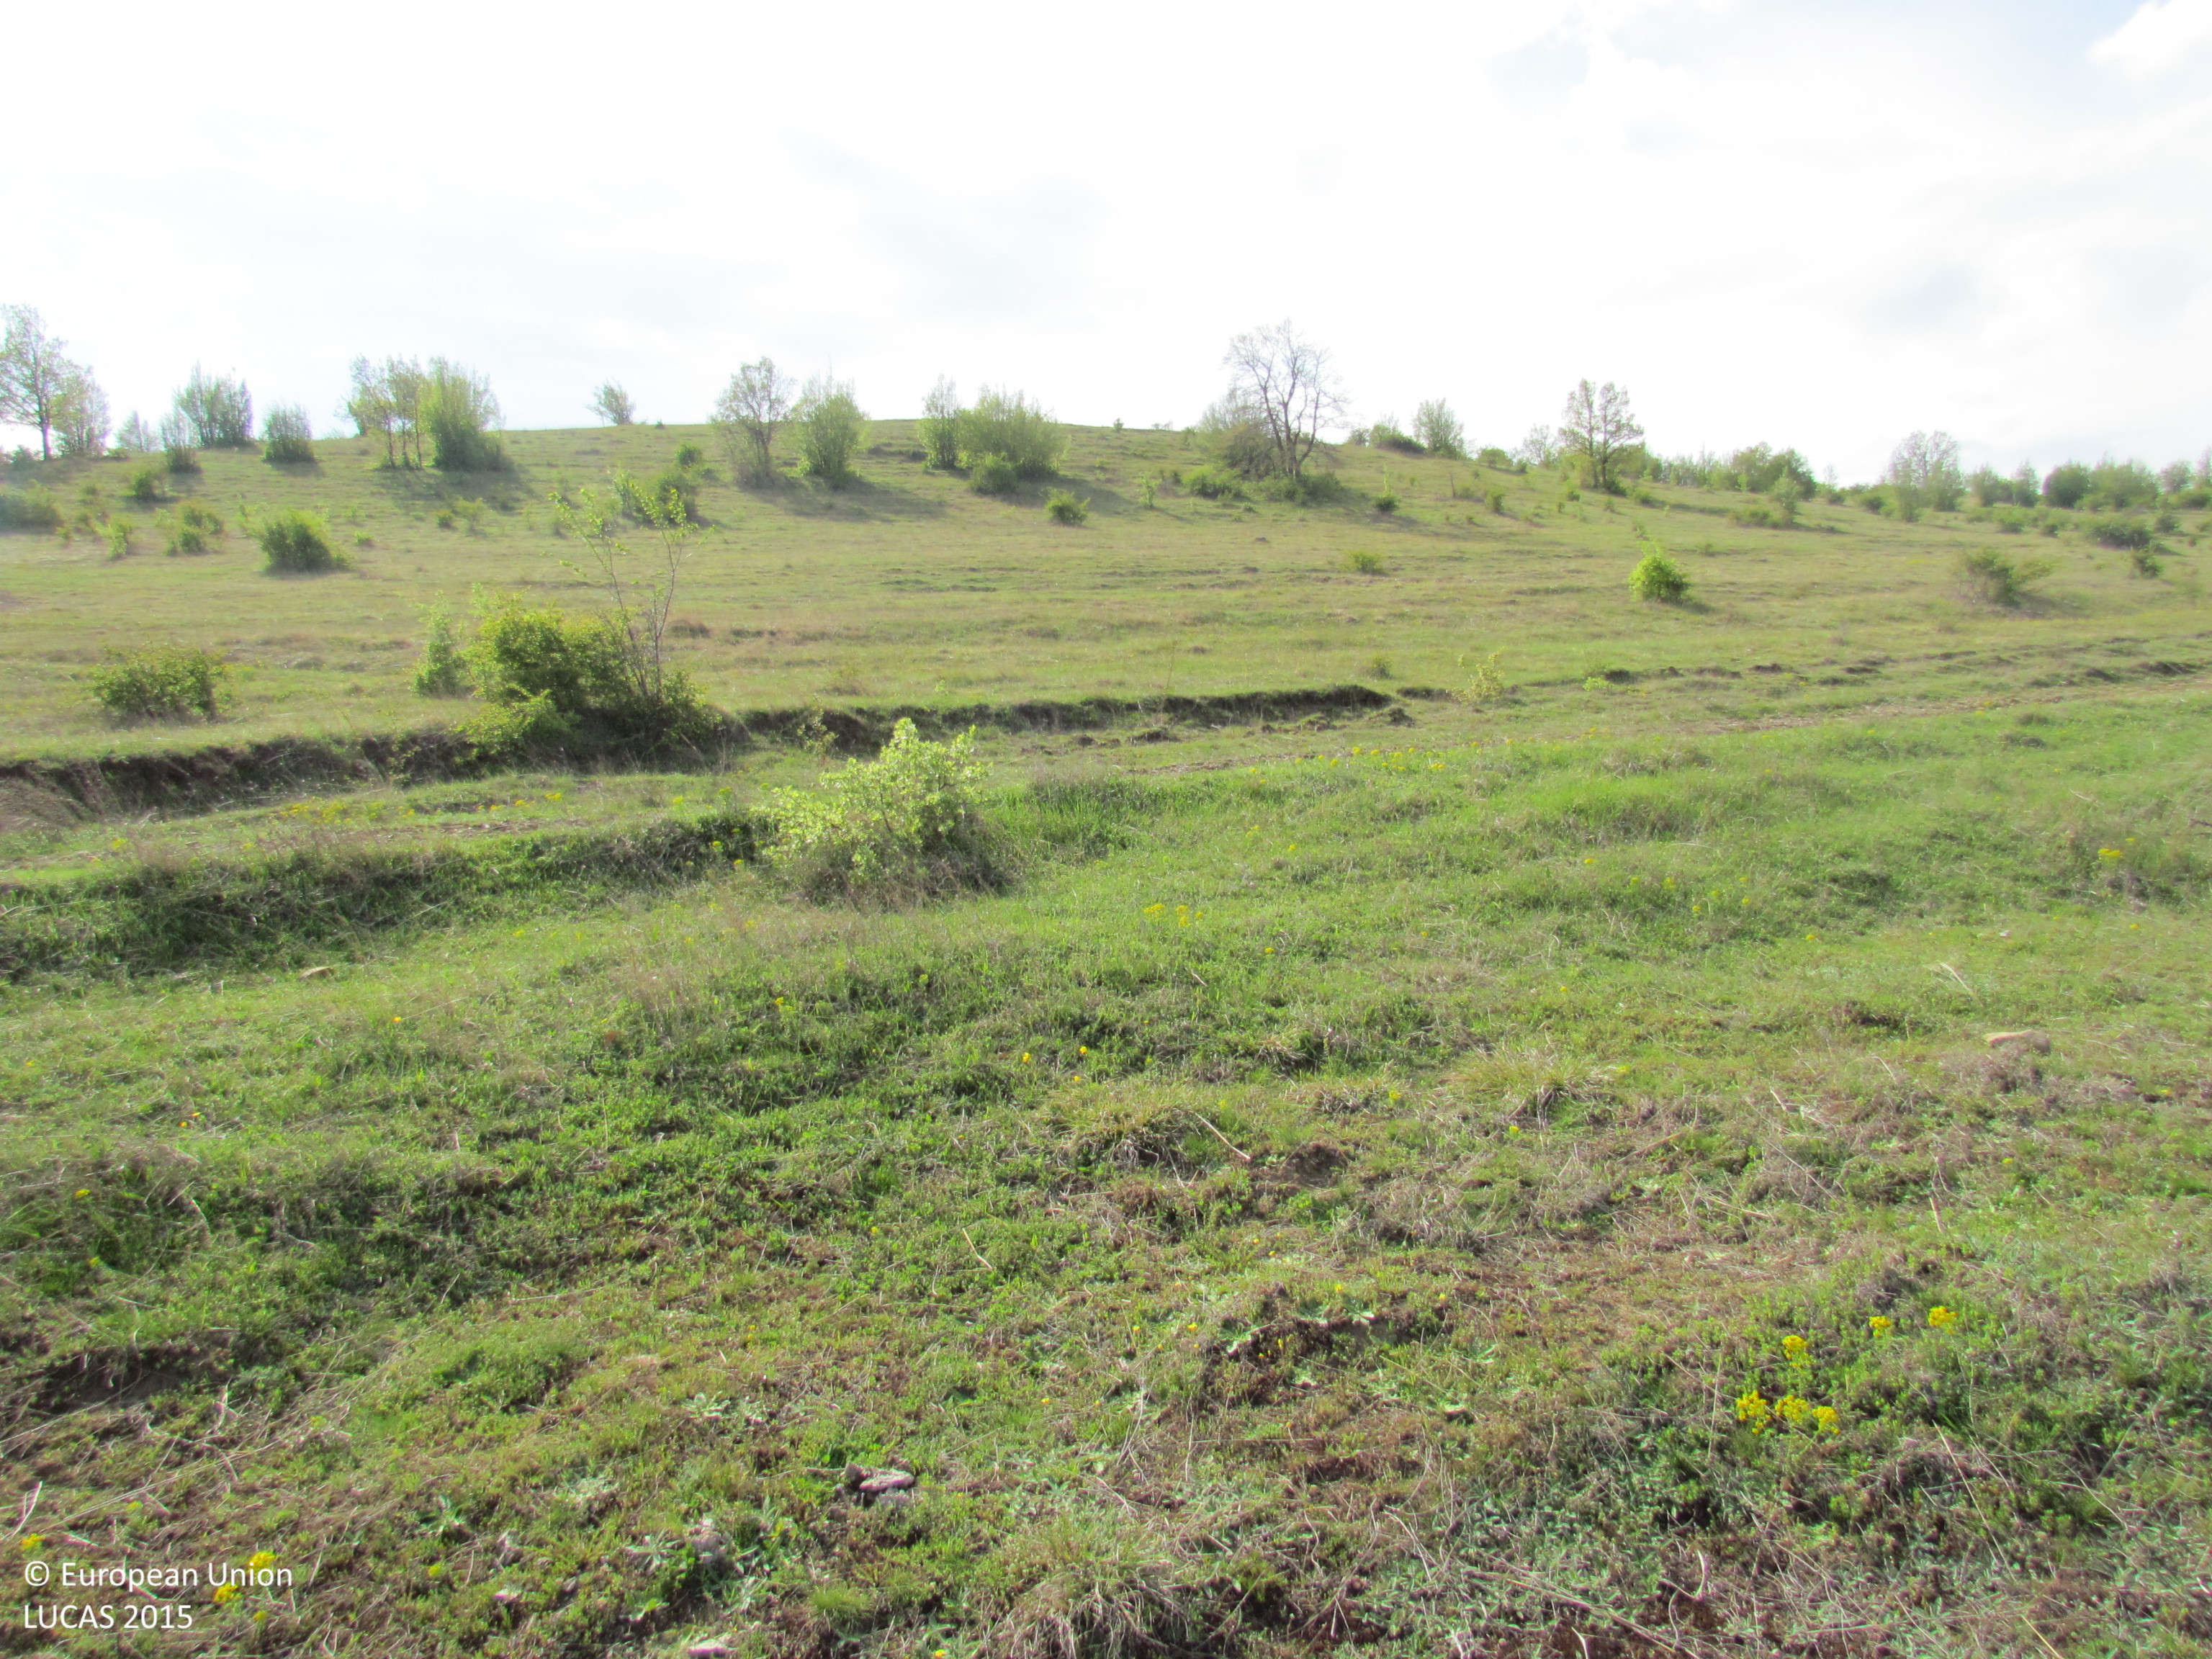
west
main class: Grassland
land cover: Grassland without tree/shrub cover
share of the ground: > 75 %
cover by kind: herbaceous plants 100 %
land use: Agriculture (excluding fallow land and kitchen gardens)
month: April
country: BG
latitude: 42.8824
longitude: 26.7670
